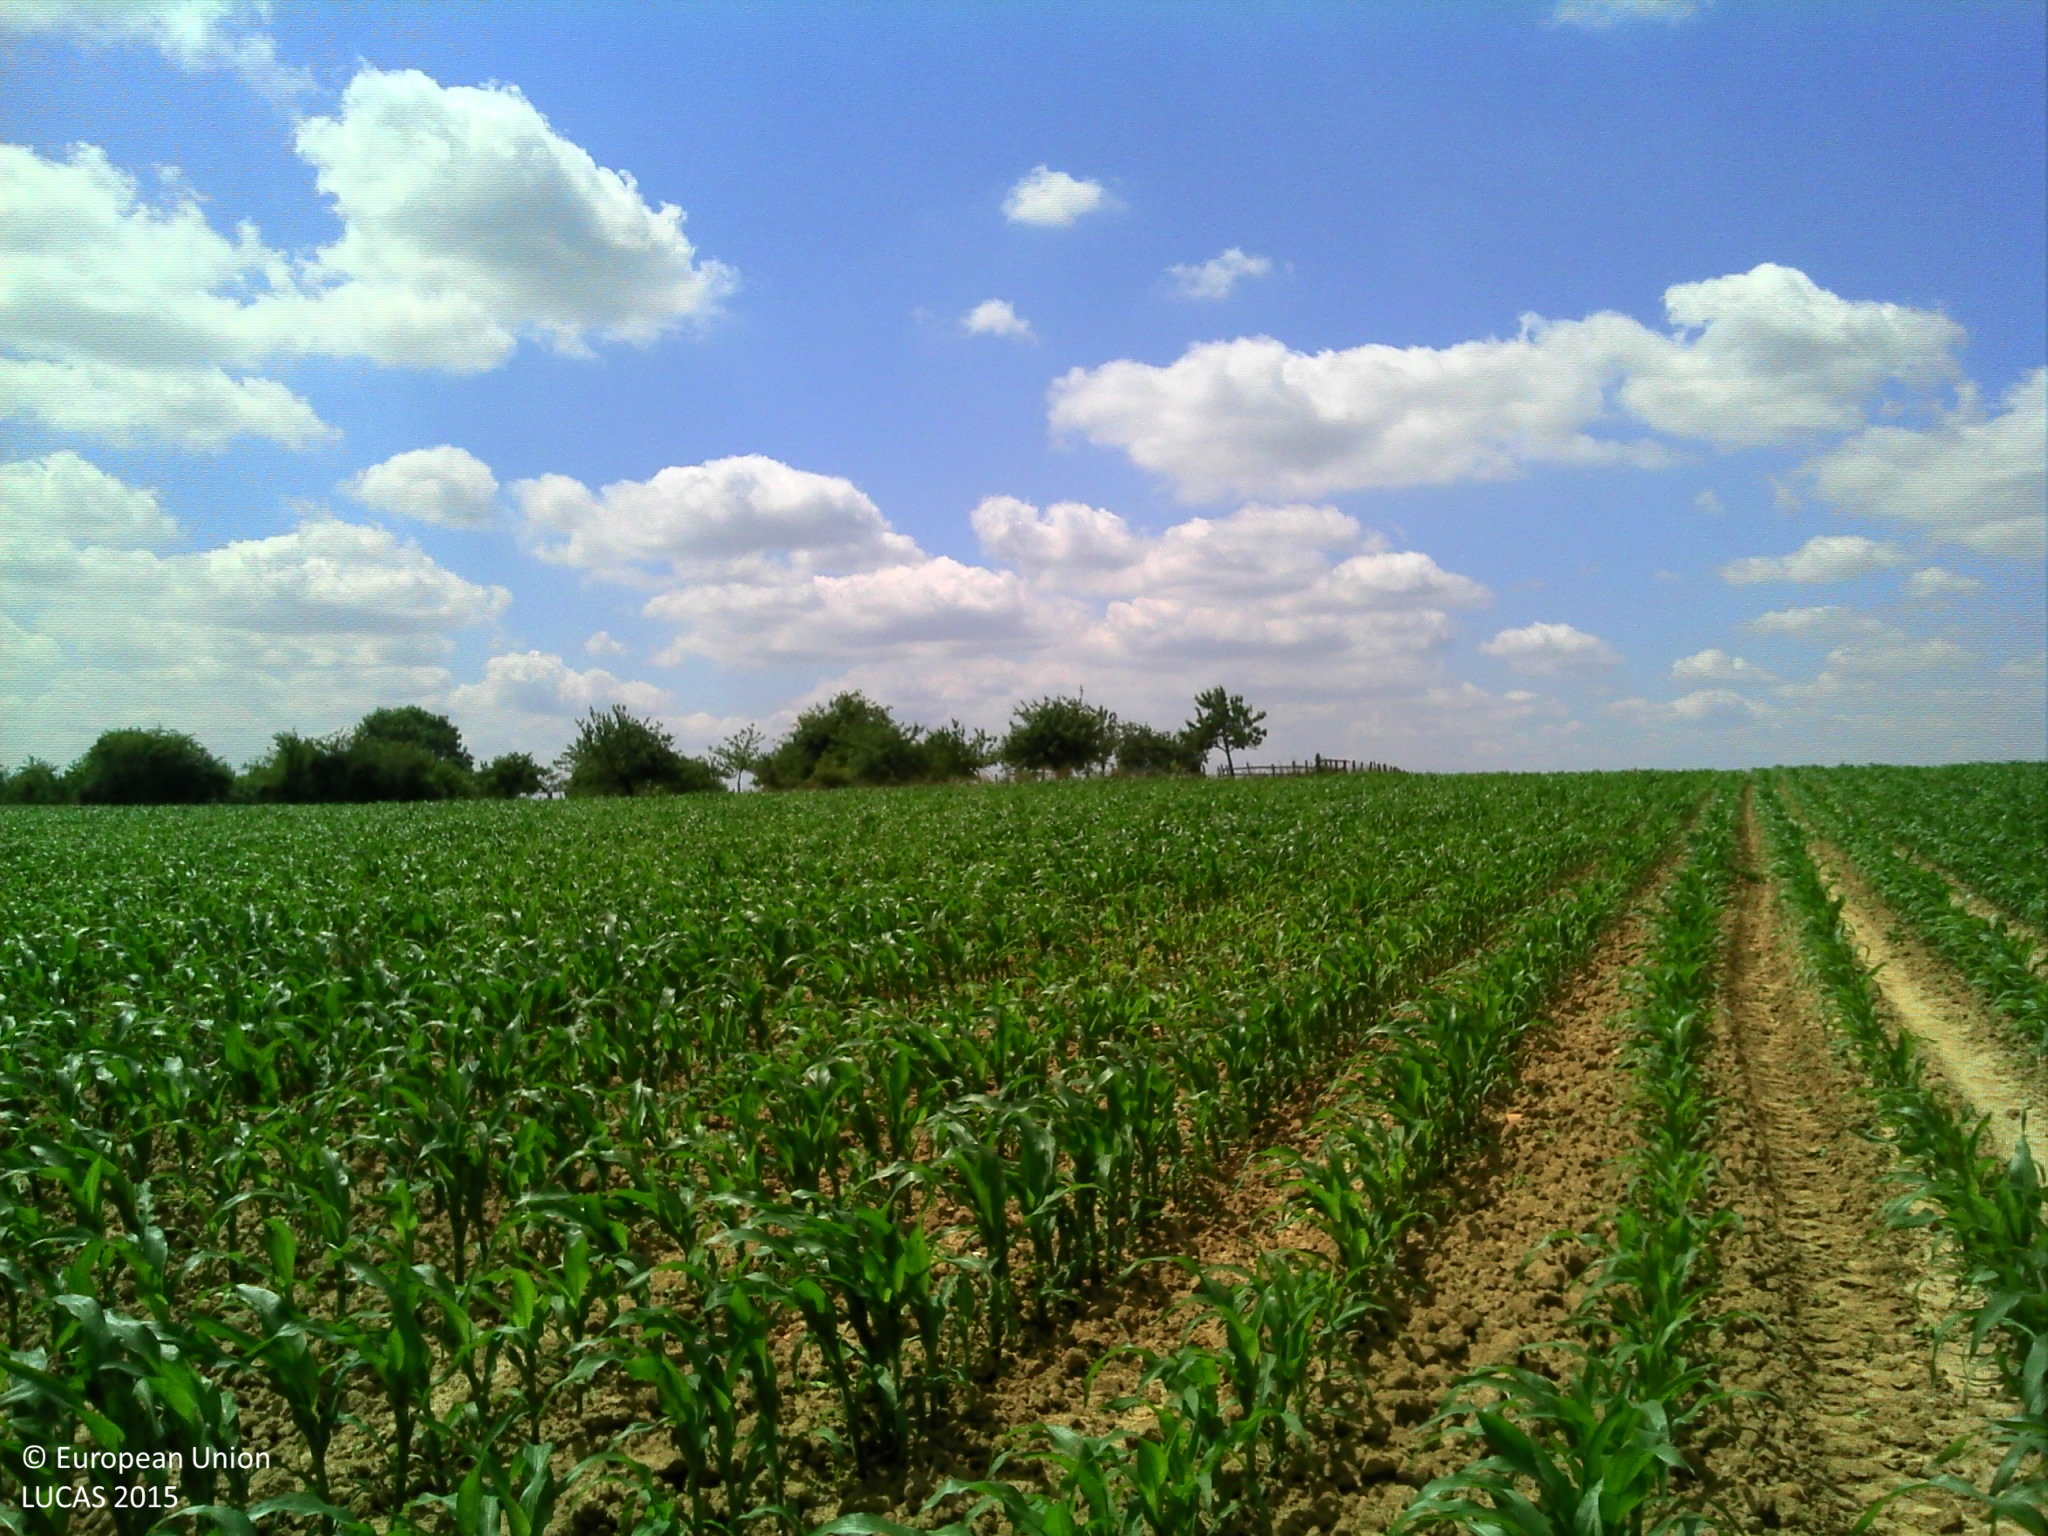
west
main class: Cropland
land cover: Maize
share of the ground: 25 - 50 %
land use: Agriculture (excluding fallow land and kitchen gardens)
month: June
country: FR
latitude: 48.2732
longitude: 0.1774
